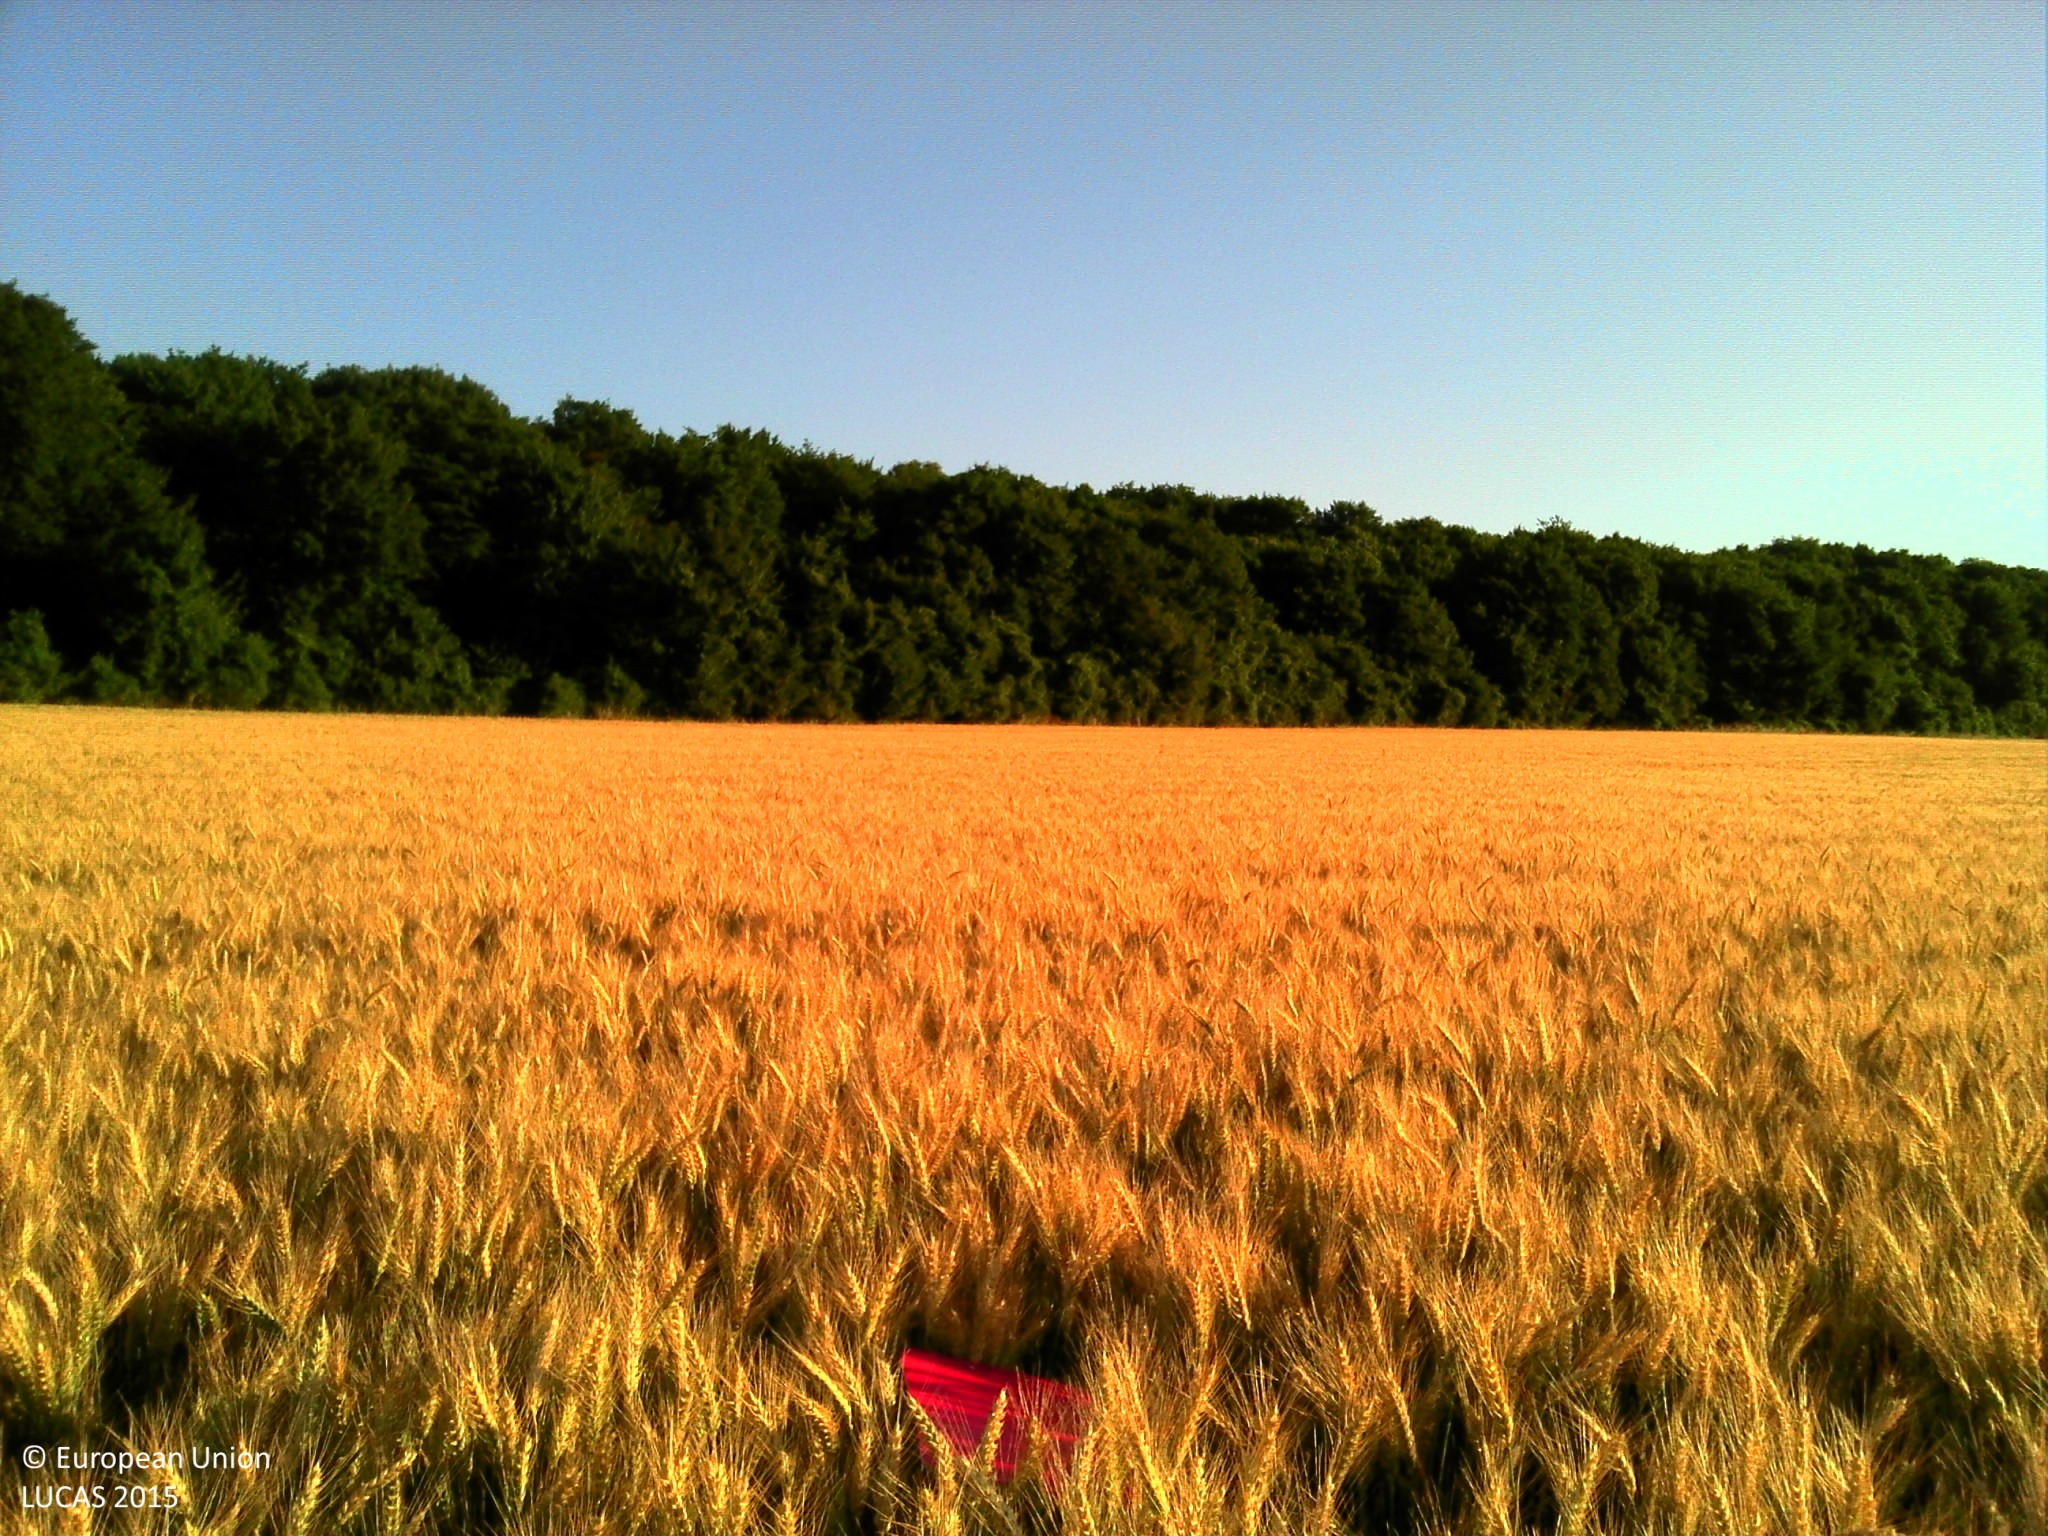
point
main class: Cropland
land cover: Common wheat
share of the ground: > 75 %
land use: Agriculture (excluding fallow land and kitchen gardens)
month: June
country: FR
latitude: 49.4277
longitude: 2.4459
